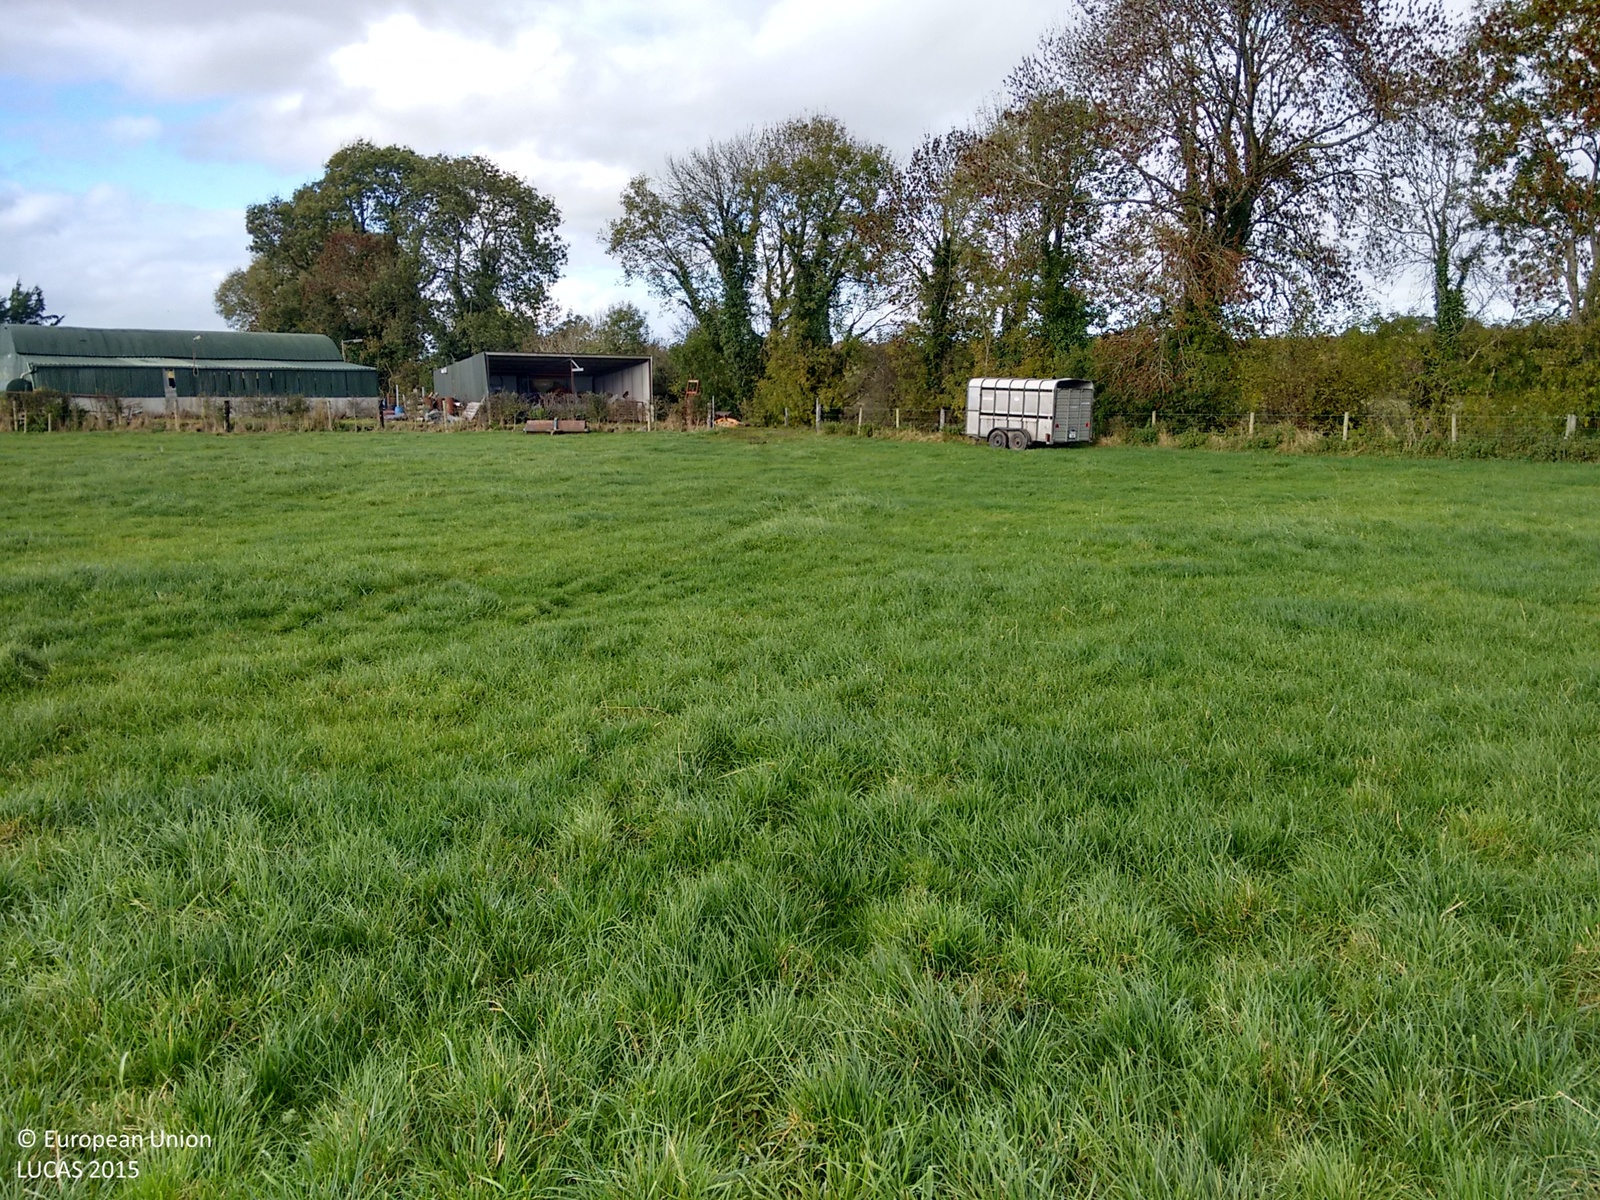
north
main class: Grassland
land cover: Grassland without tree/shrub cover
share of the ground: > 75 %
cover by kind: herbaceous plants 100 %
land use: Agriculture (excluding fallow land and kitchen gardens)
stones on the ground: < 10 %
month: October
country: IE
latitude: 53.2725
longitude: -7.7564
